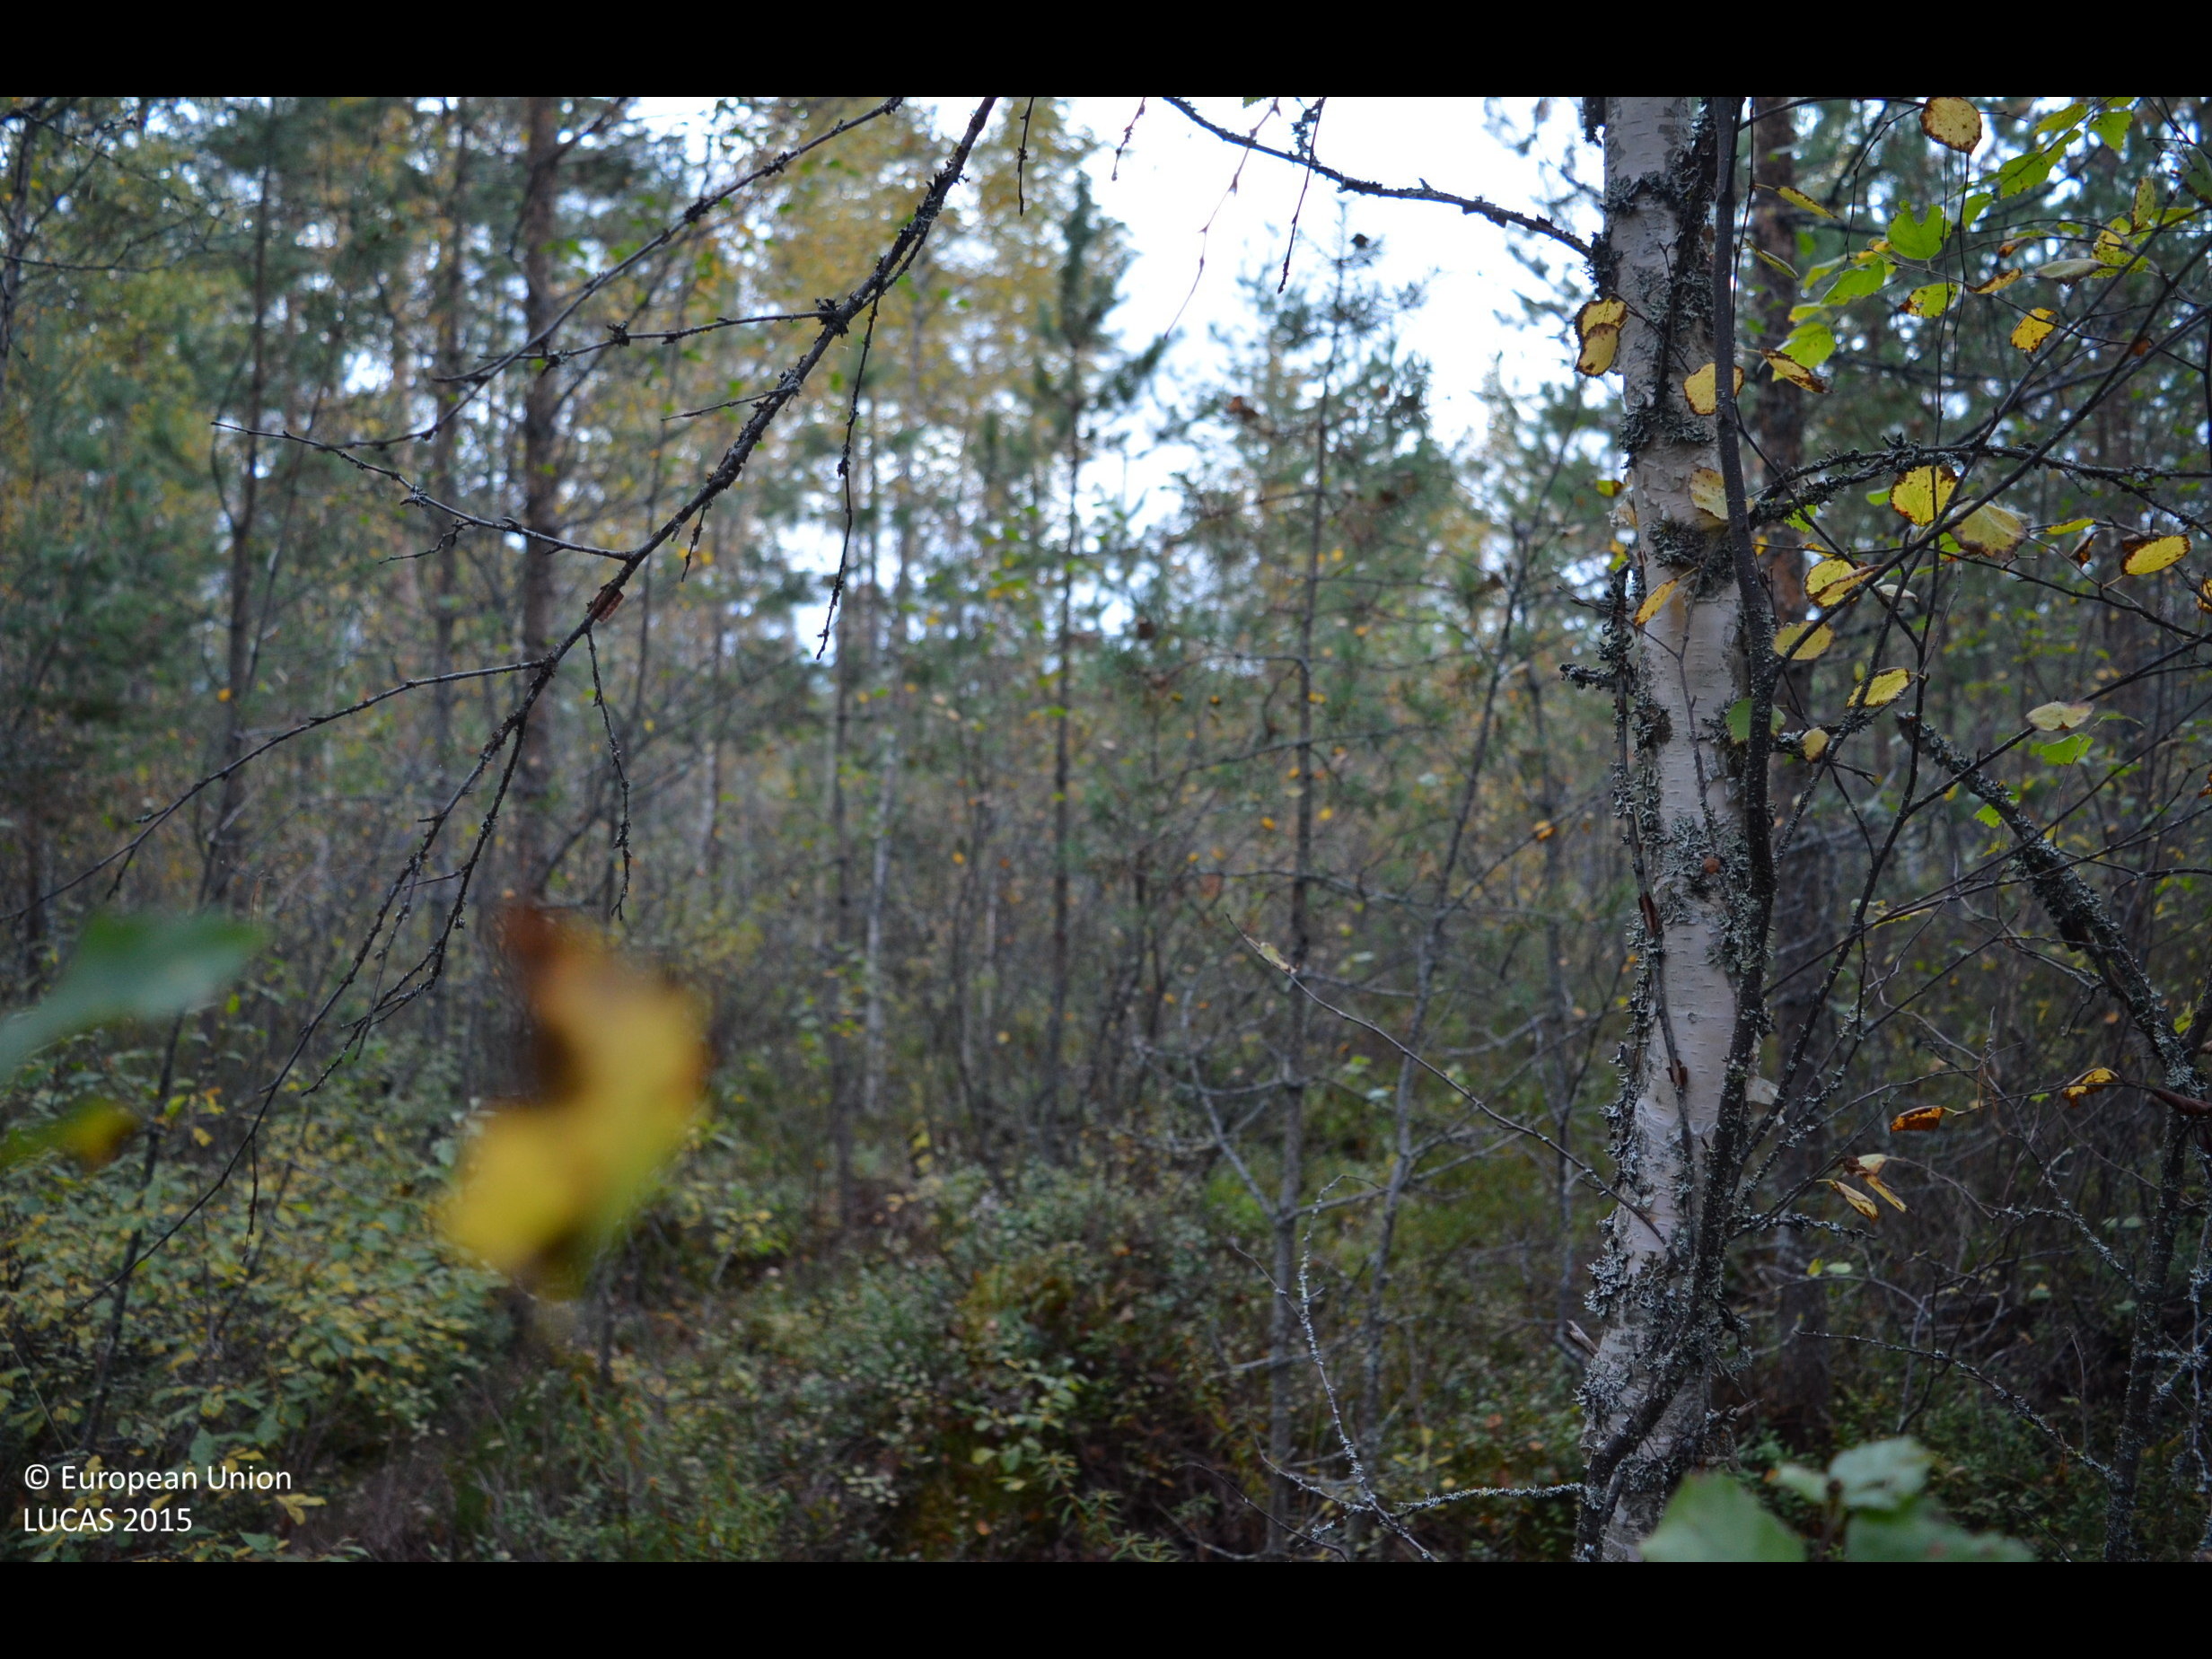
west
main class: Woodland
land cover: Pine dominated mixed woodland
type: boreal forest
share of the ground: > 75 %
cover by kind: coniferous forest trees 55 %, broadleaved forest trees 30 %, shrubs 15 %
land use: Forestry
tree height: > 5 m
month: September
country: FI
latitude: 62.8150
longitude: 23.8273
